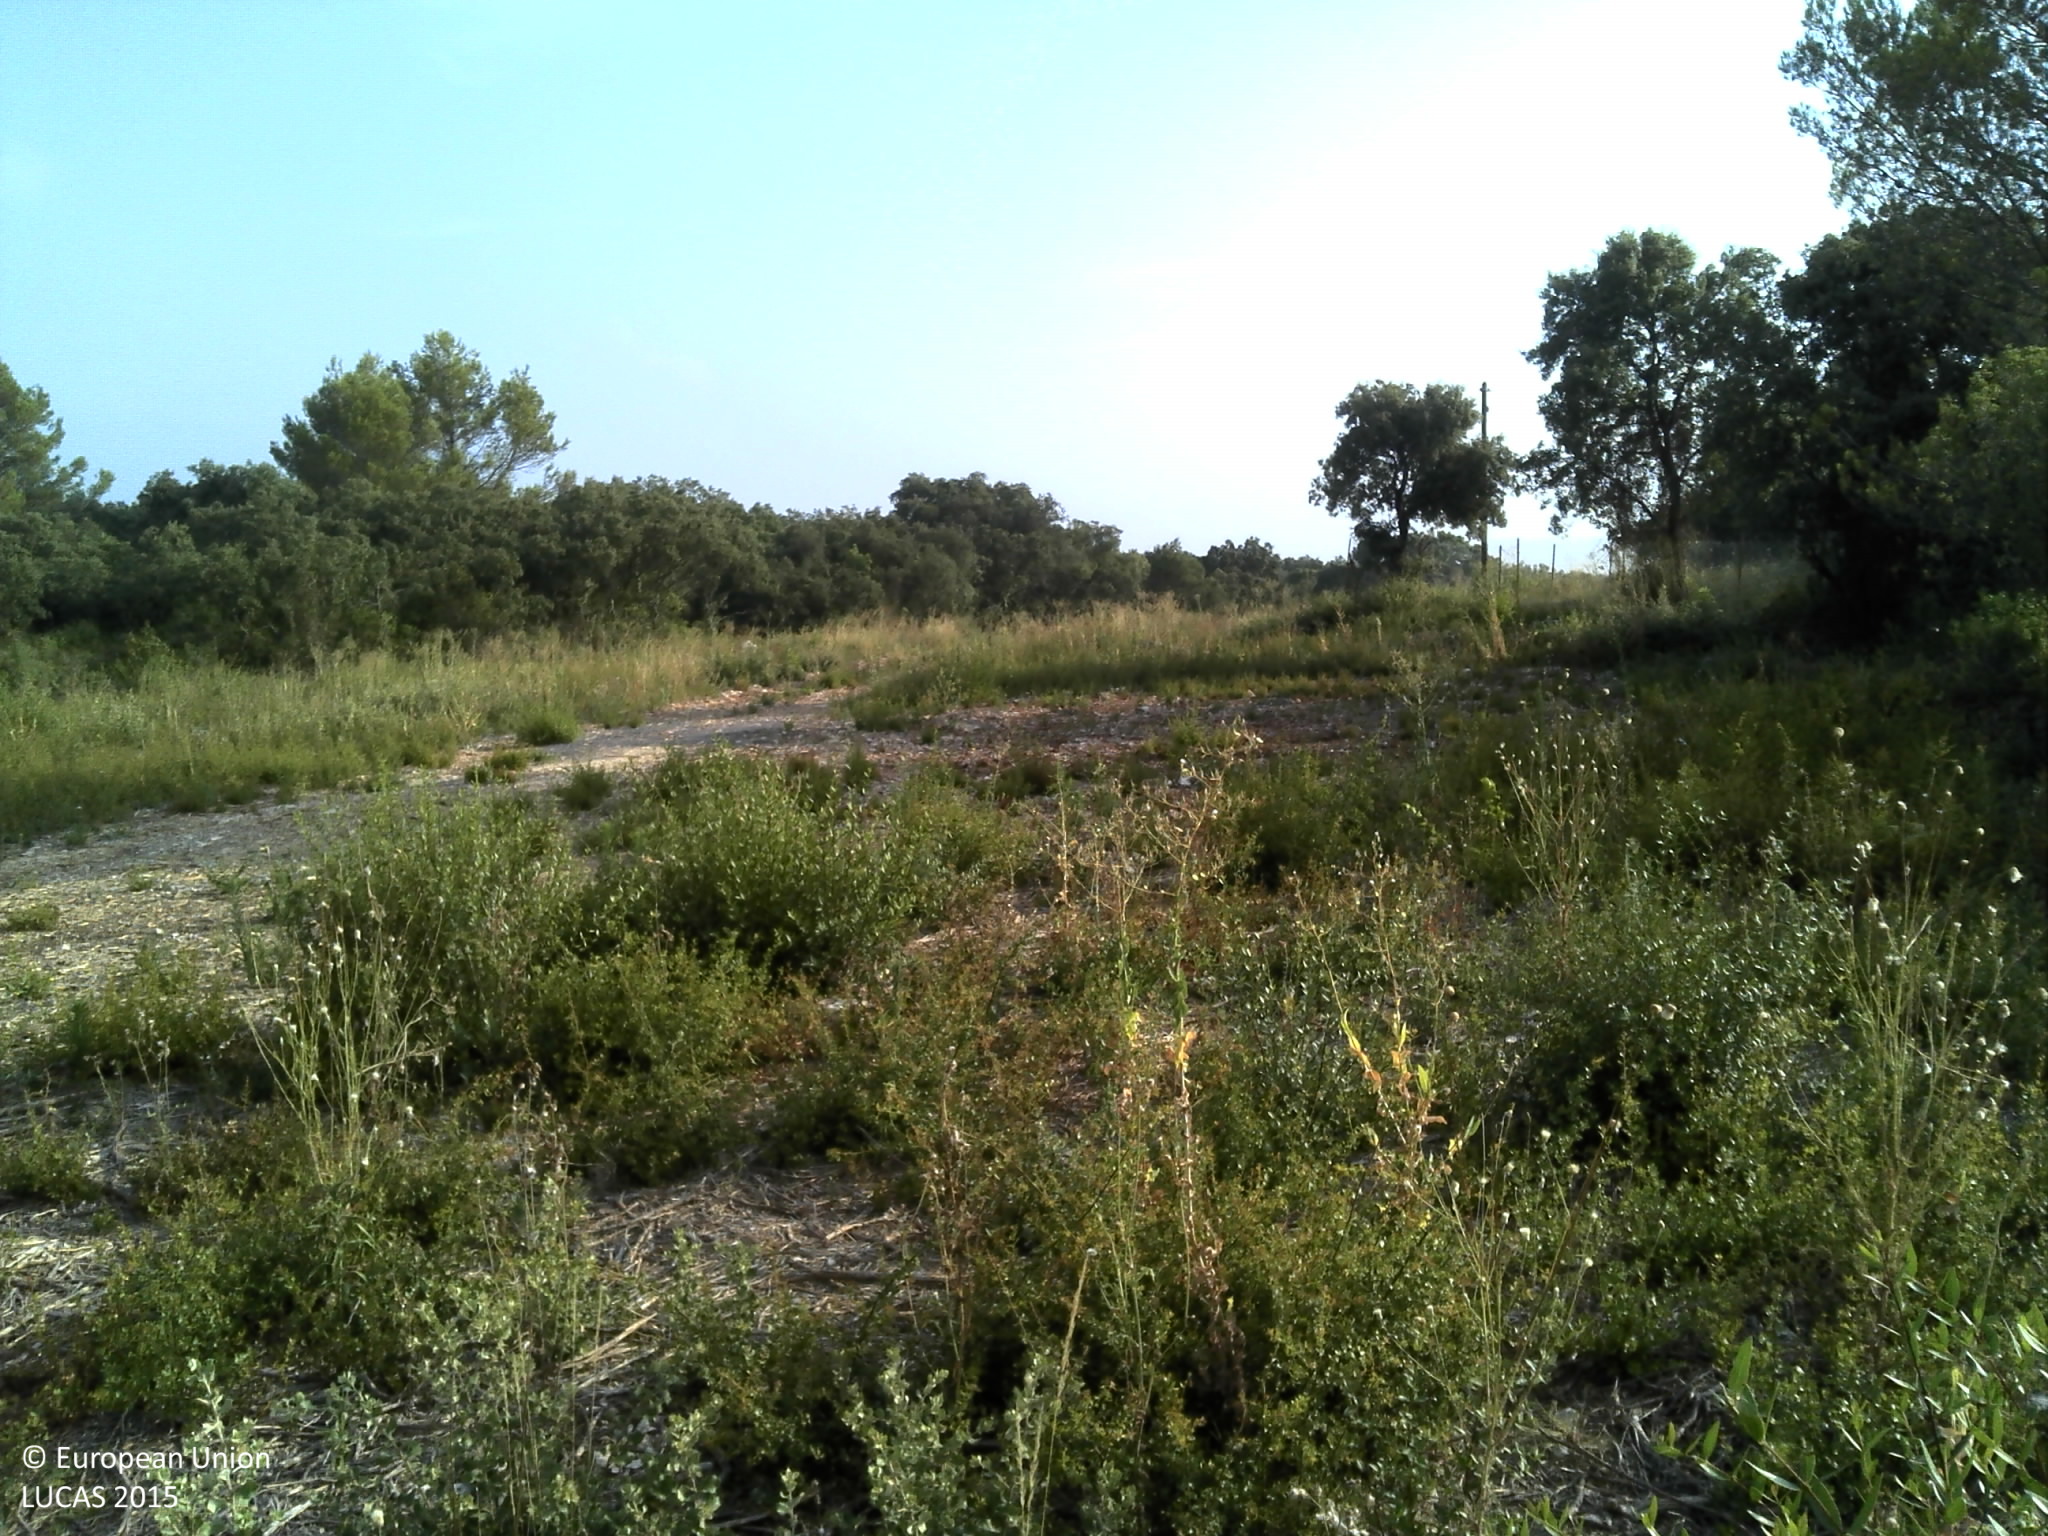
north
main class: Shrubland
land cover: Shrubland with sparse tree cover
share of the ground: > 75 %
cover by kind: shrubs 65 %, herbaceous plants 10 %, consolidated bare surface 10 %, unconsolidated bare surface 10 %, broadleaved forest trees 5 %
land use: Semi-natural and natural areas not in use
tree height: < 5 m
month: July
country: FR
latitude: 43.6702
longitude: 3.9939
